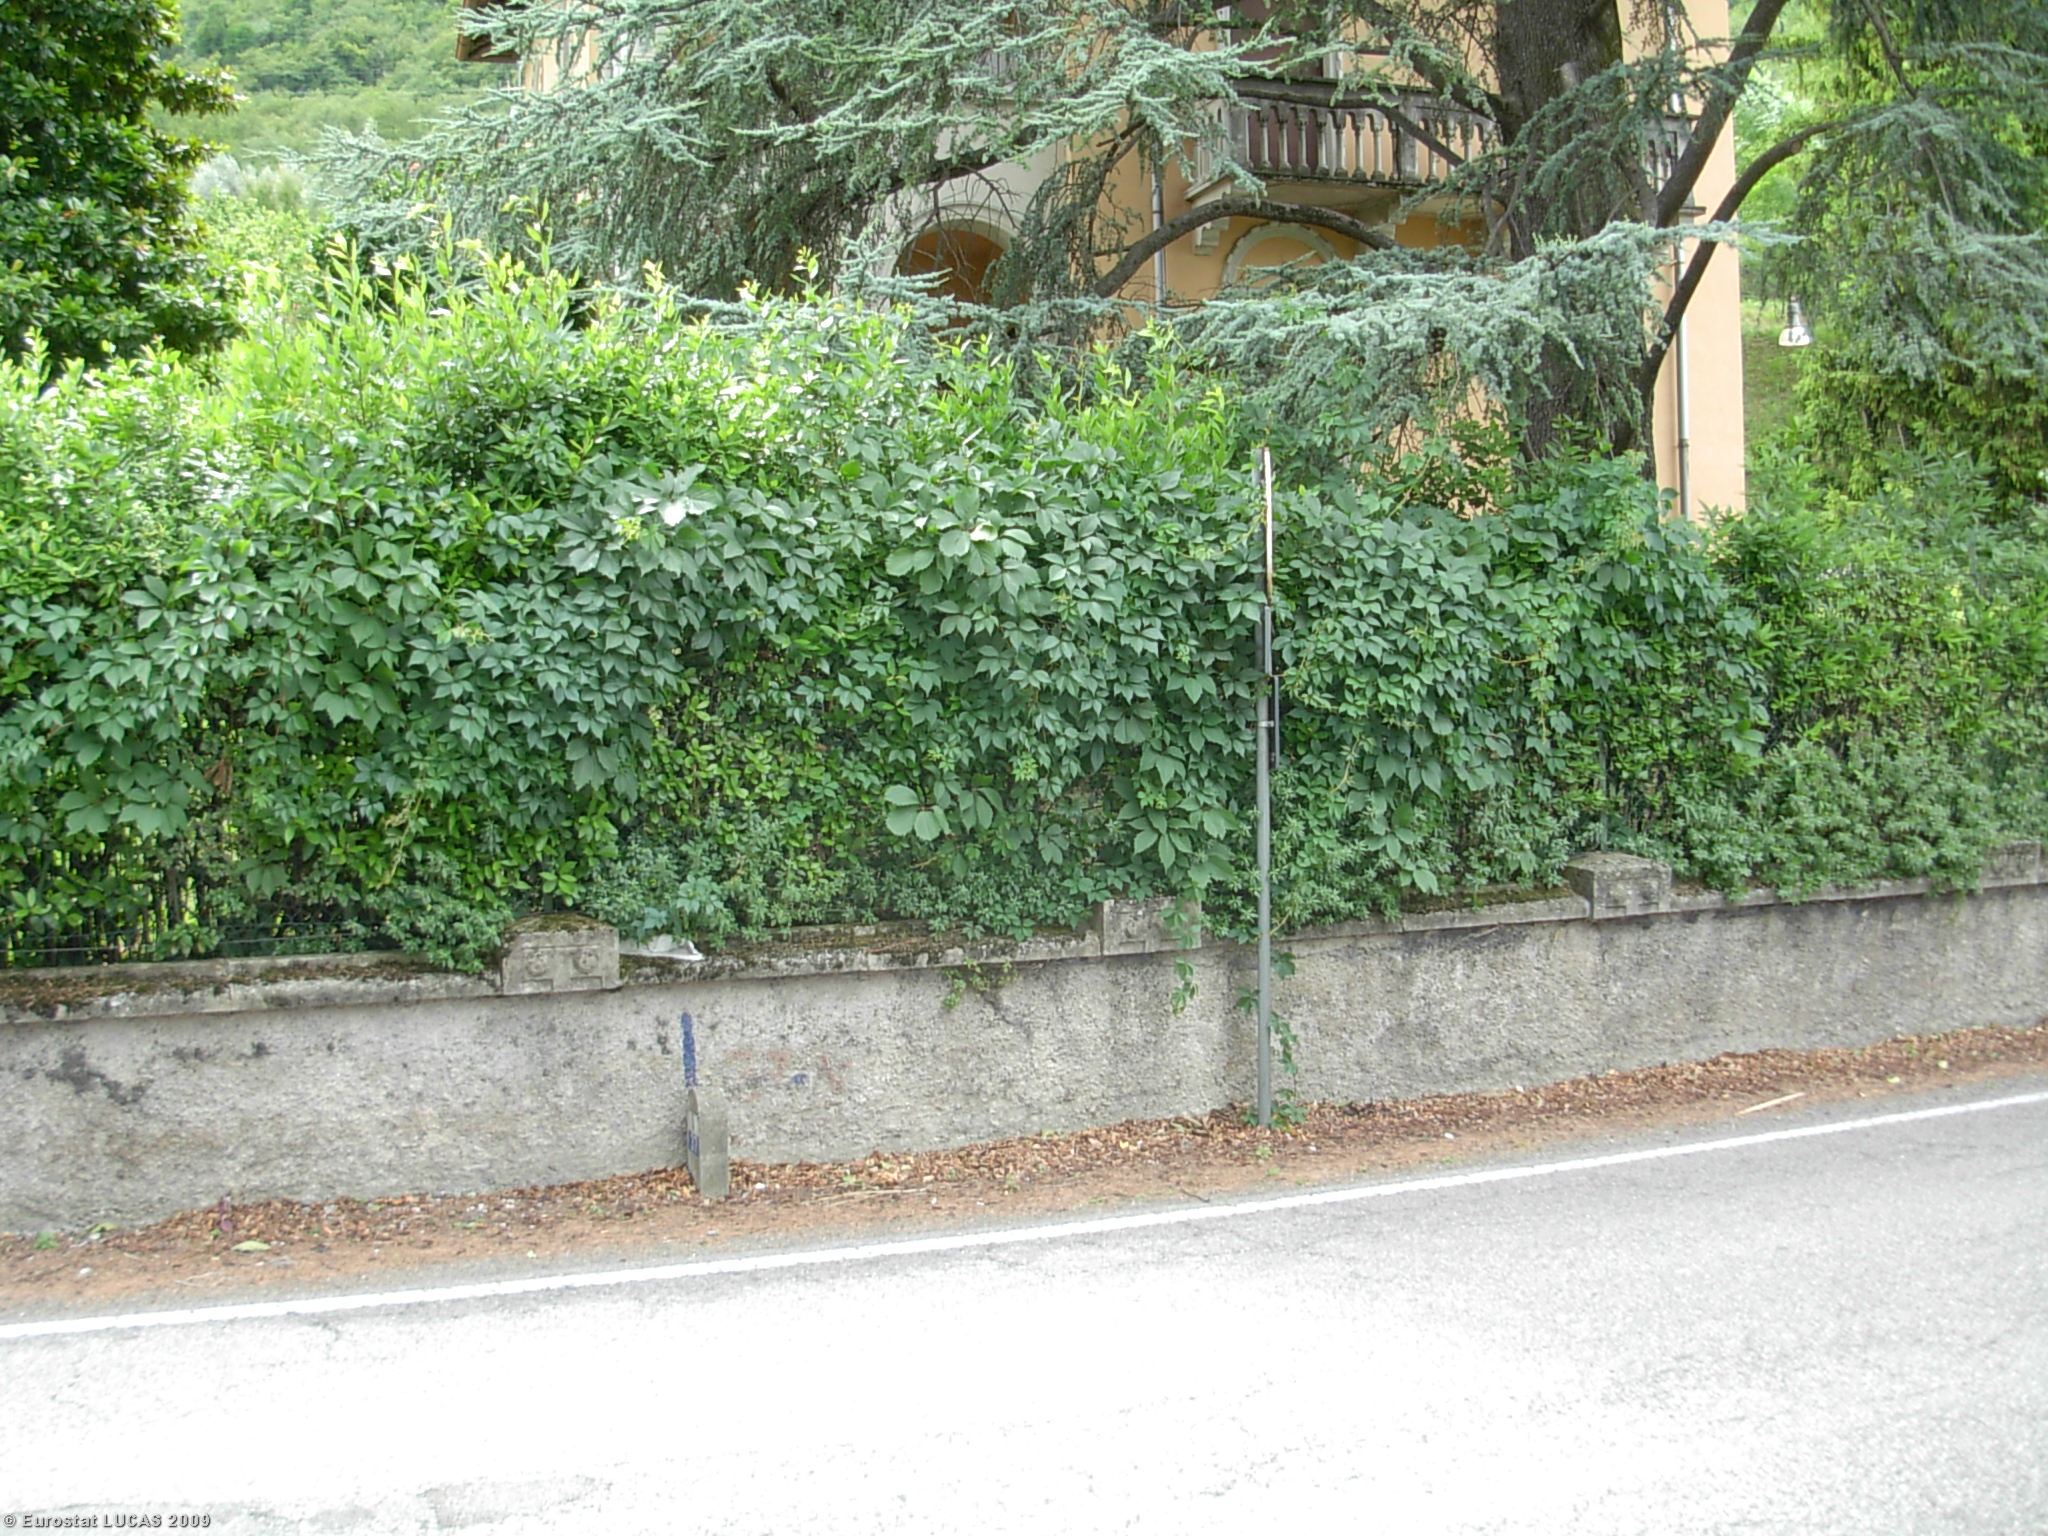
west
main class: Woodland
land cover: Coniferous woodland
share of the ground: > 75 %
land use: Holiday camps
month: June
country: IT
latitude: 45.9165
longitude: 9.2920
